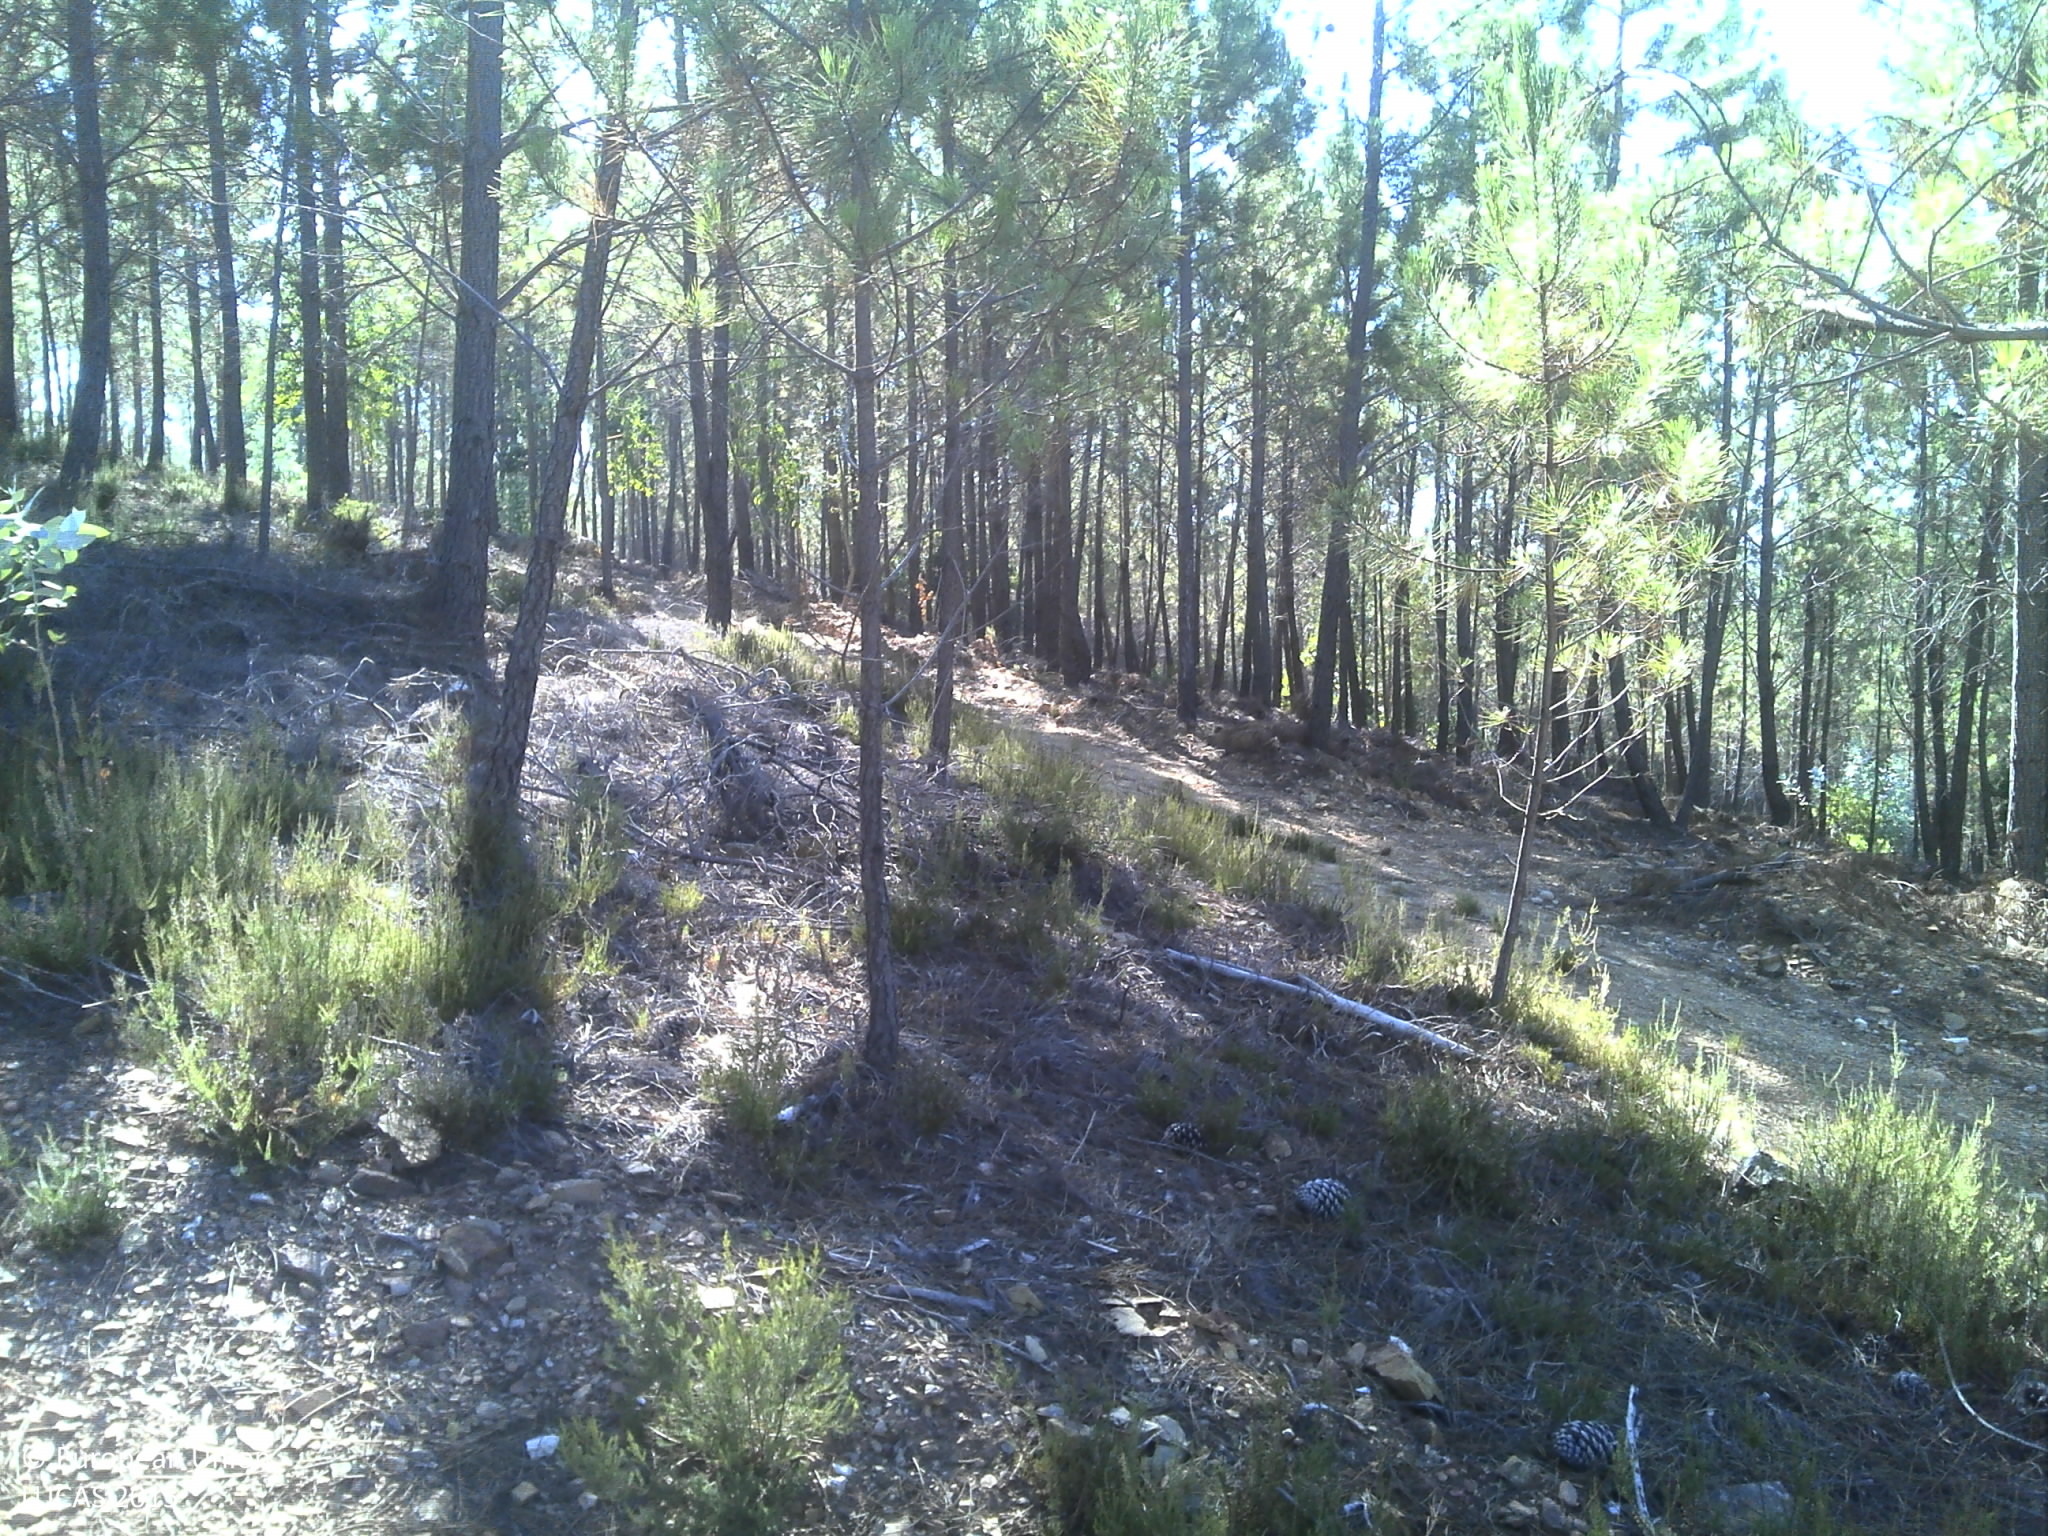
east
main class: Woodland
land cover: Pine dominated coniferous woodland
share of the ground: 50 - 75 %
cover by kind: coniferous forest trees 60 %, unconsolidated bare surface 30 %, shrubs 10 %
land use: Forestry
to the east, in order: Pine dominated coniferous woodland; Tracks; Pine dominated coniferous woodland; Tracks; Pine dominated coniferous woodland; Tracks; Pine dominated coniferous woodland
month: July
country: PT
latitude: 40.0859
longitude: -7.6888
